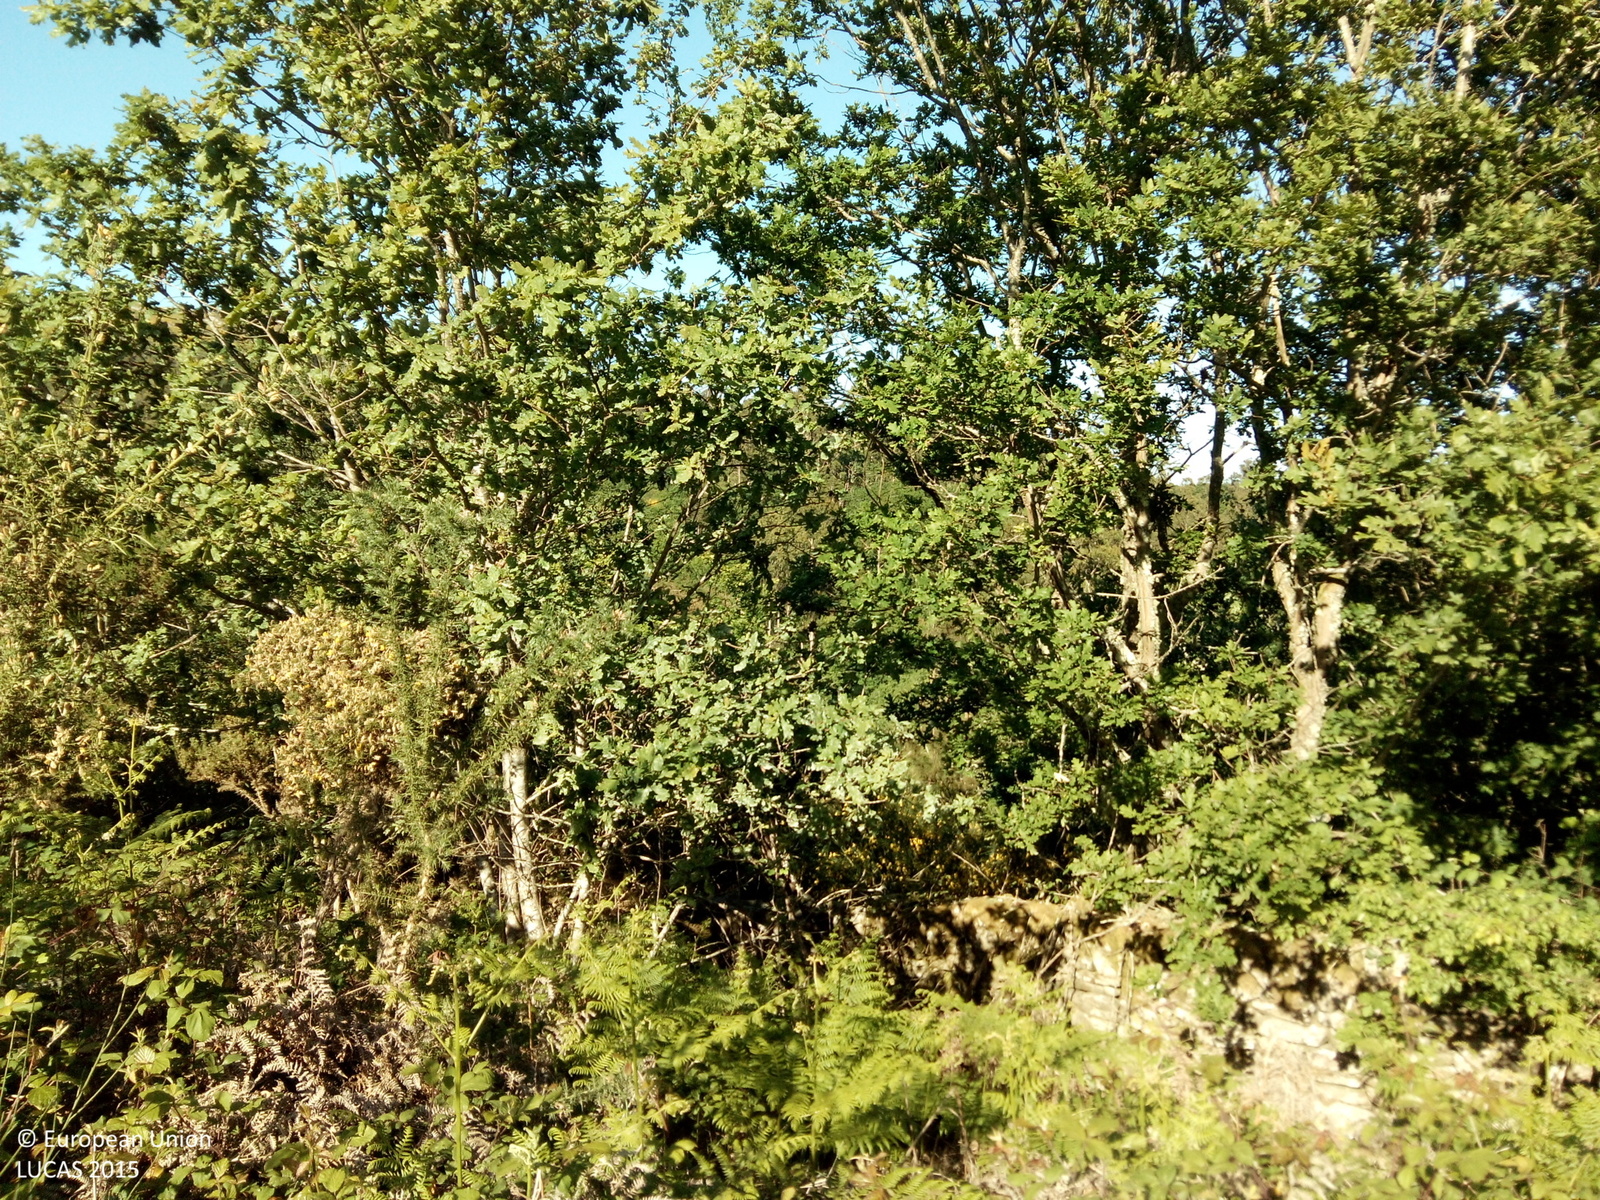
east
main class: Woodland
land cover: Broadleaved woodland
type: acidophilous oak and oak-birch forest
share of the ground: > 75 %
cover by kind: broadleaved forest trees 100 %
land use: Forestry
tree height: > 5 m
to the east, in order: Broadleaved woodland; Tracks; Dry stone walls; Broadleaved woodland; Other mixed woodland; Dry stone walls; Other mixed woodland
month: May
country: ES
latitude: 42.5360
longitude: -8.4204
